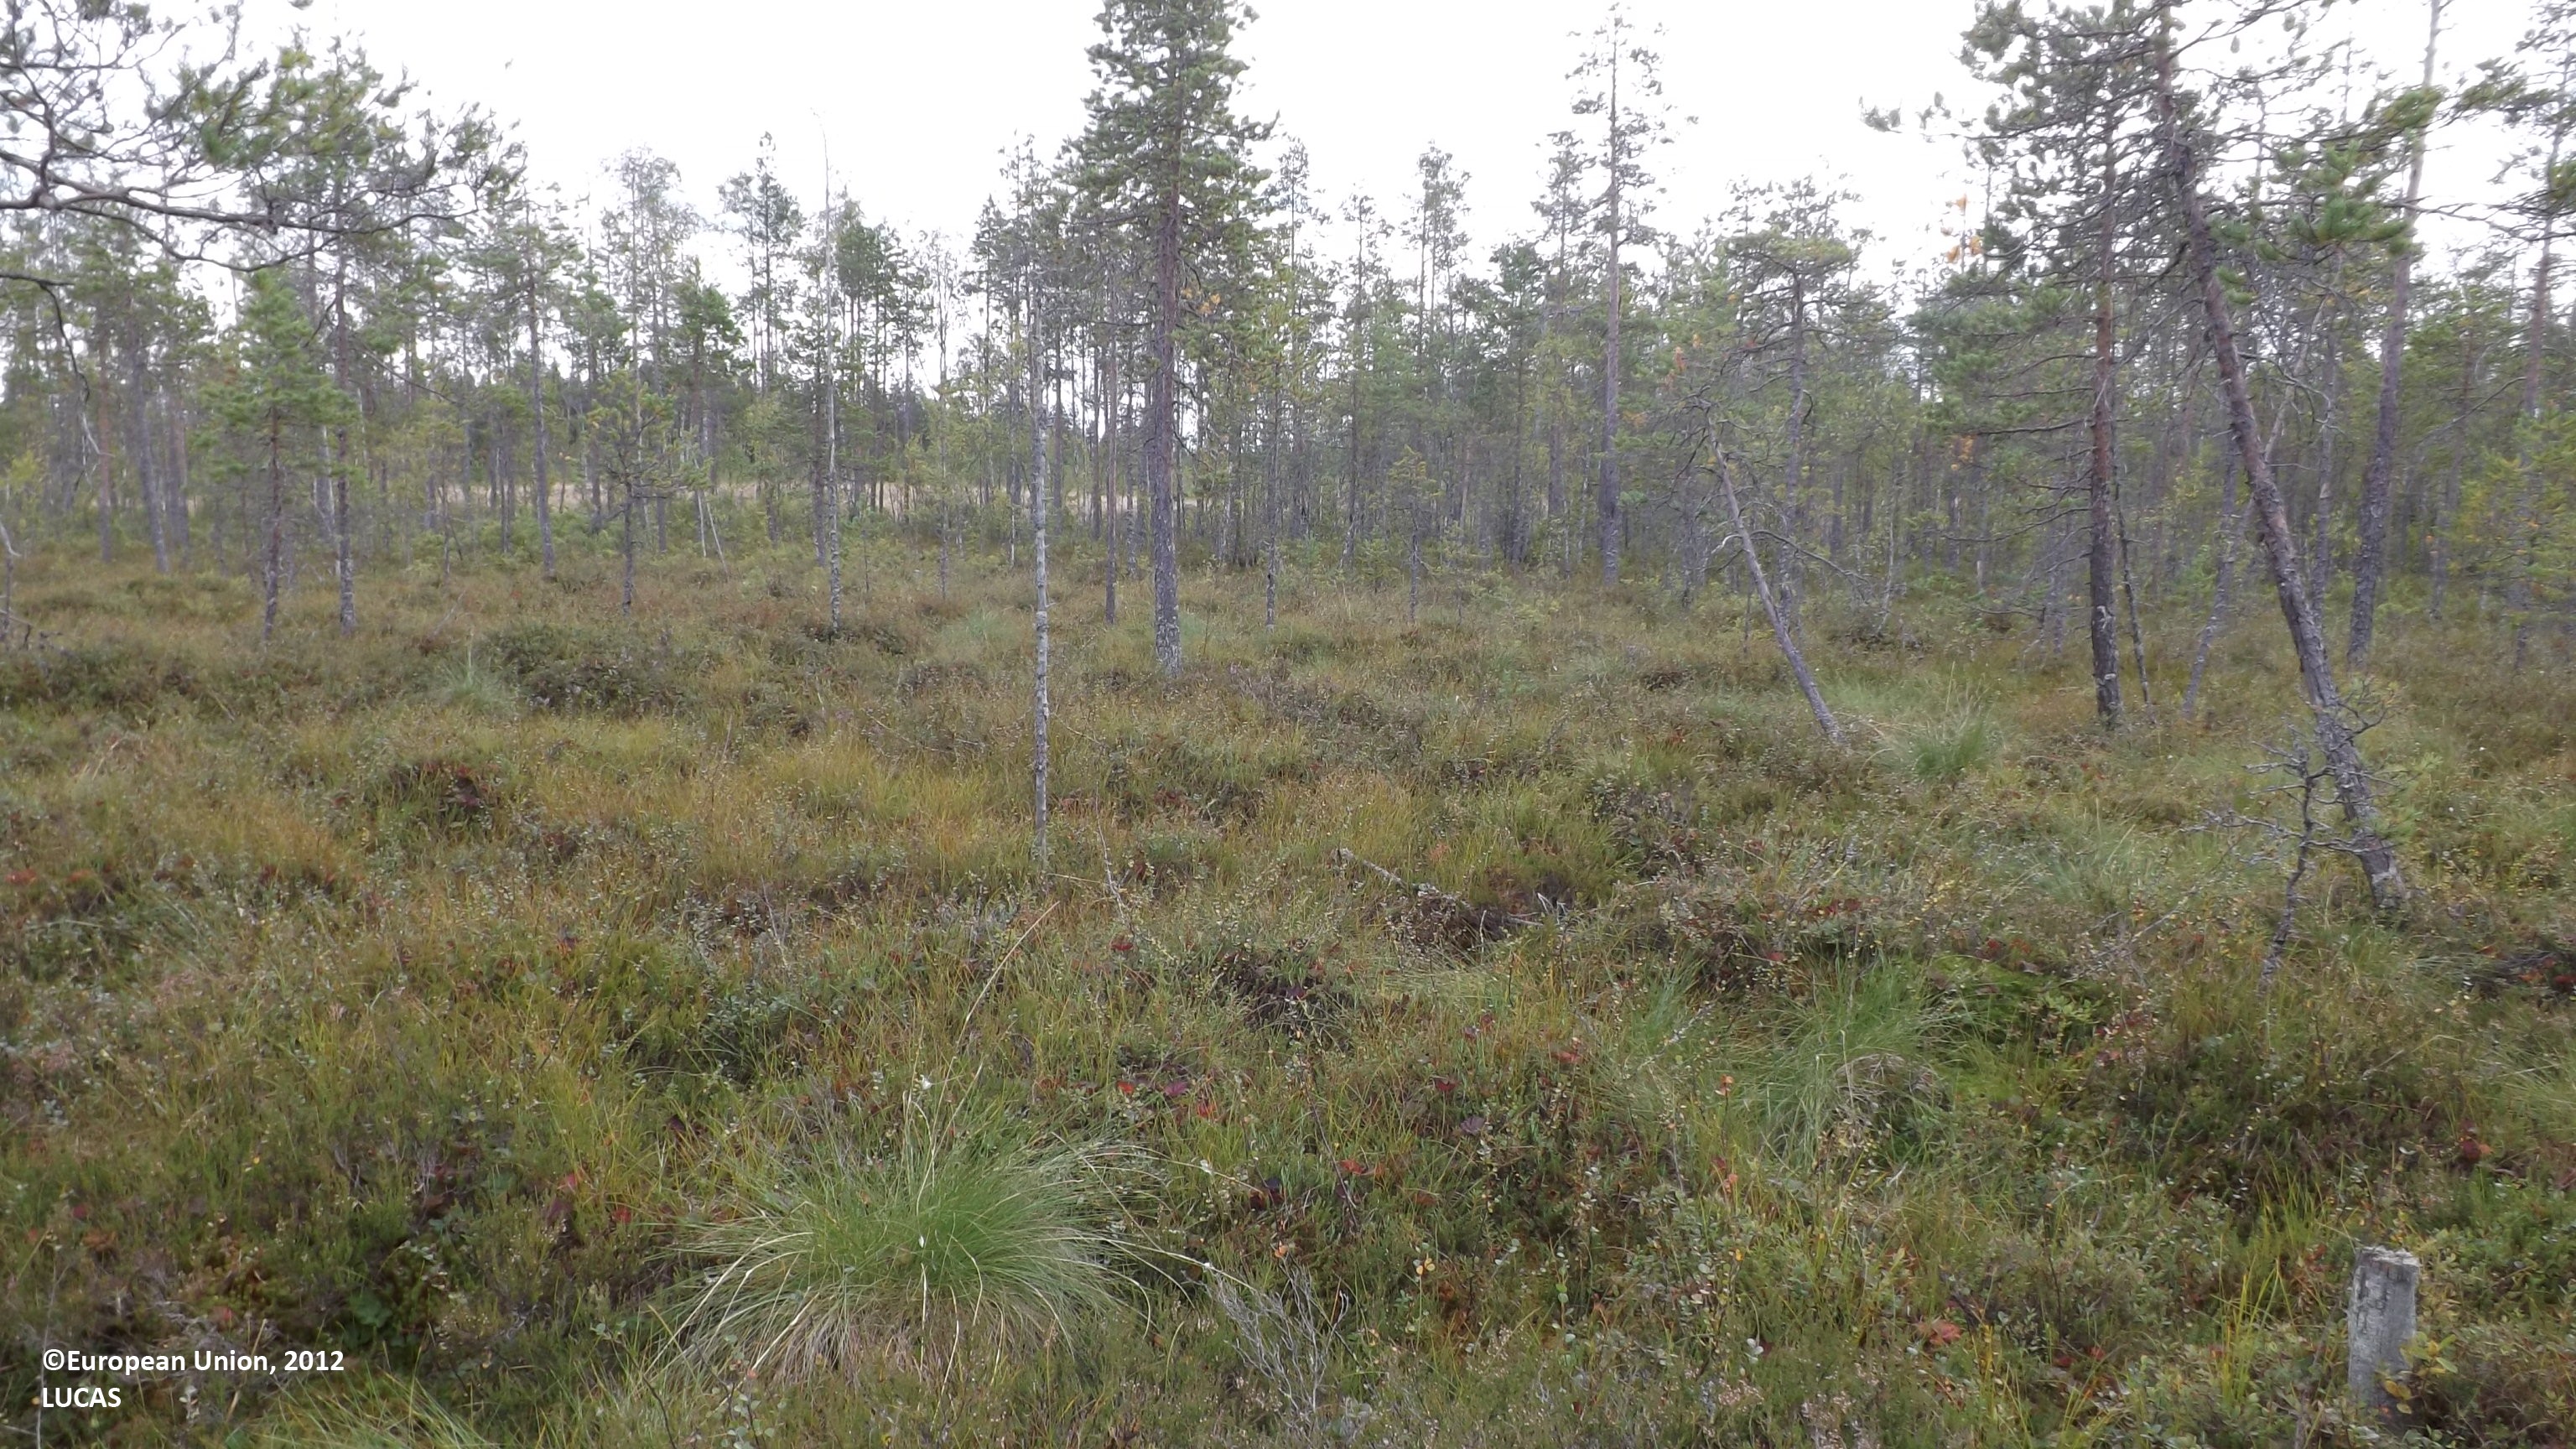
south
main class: Woodland
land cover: Pine dominated coniferous woodland
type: mire and swamp forests
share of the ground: 10 - 25 %
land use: Semi-natural and natural areas not in use
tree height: > 5 m
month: August
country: FI
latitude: 63.7839
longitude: 24.0892
